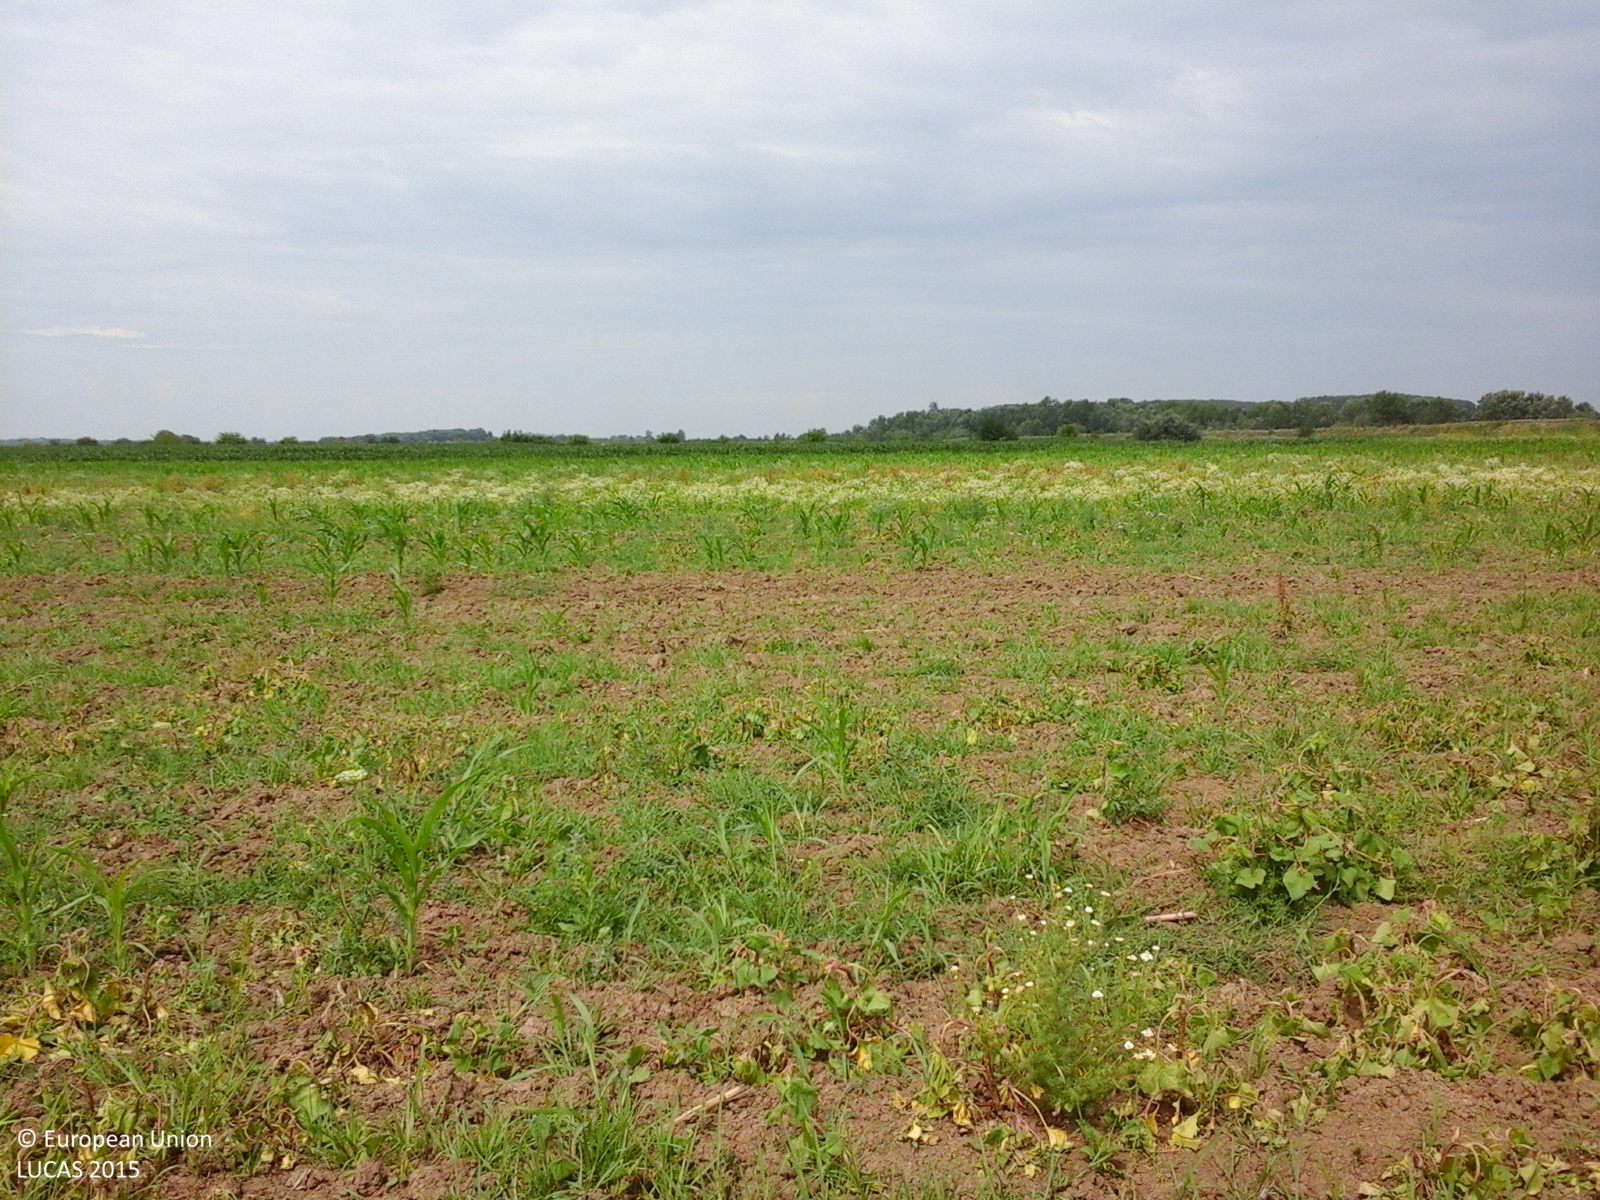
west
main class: Cropland
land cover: Maize
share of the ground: < 10 %
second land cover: Spontaneously vegetated surfaces
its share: 50 - 75 %
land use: Agriculture (excluding fallow land and kitchen gardens)
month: June
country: RO
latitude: 44.1849
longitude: 26.3333
